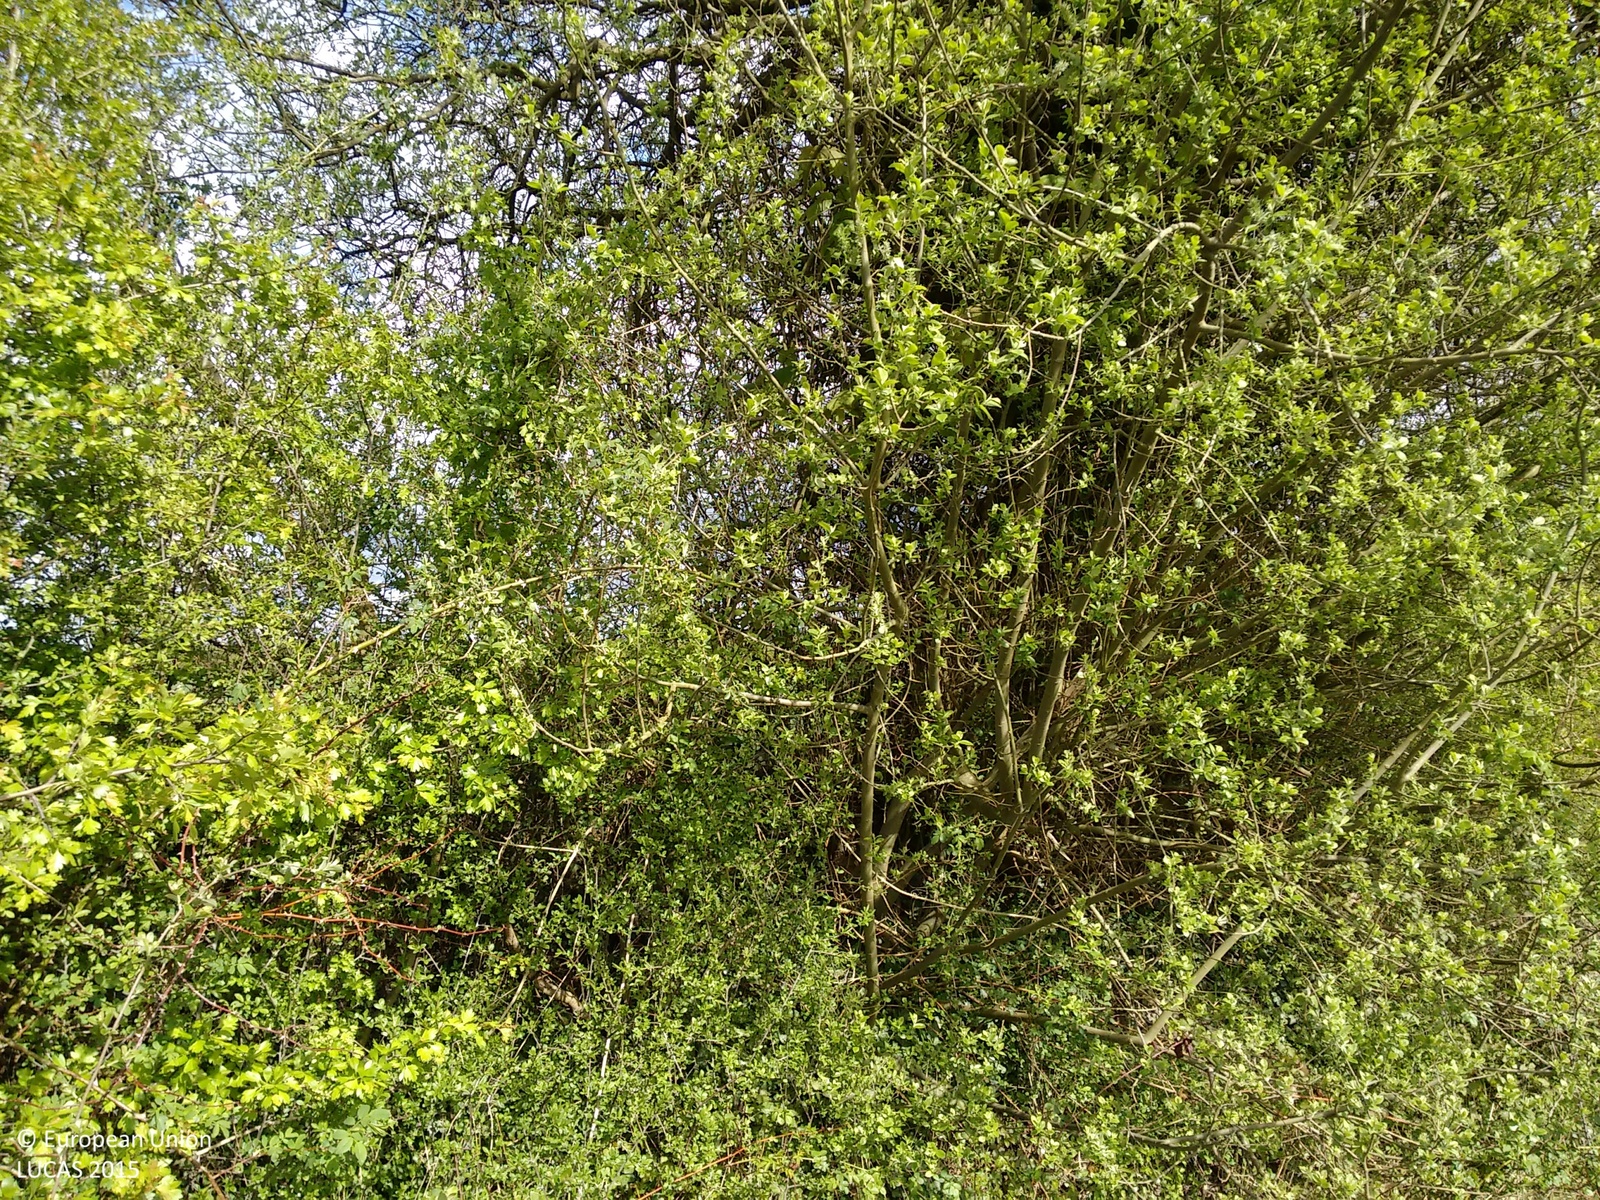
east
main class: Woodland
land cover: Broadleaved woodland
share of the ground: > 75 %
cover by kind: broadleaved forest trees 50 %, herbaceous plants 50 %
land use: Semi-natural and natural areas not in use
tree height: < 5 m
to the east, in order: Broadleaved woodland; Grass margins; Common wheat; Grass margins; Abandoned hedges; Electric lines; Fences; Grassland without tree/shrub cover; Grass margins; Tracks; Abandoned hedges; Inland fresh water bodies; Artificial constructions; Abandoned hedges; Inland fresh water bodies
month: May
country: GB
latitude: 51.9062
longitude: -0.5480
